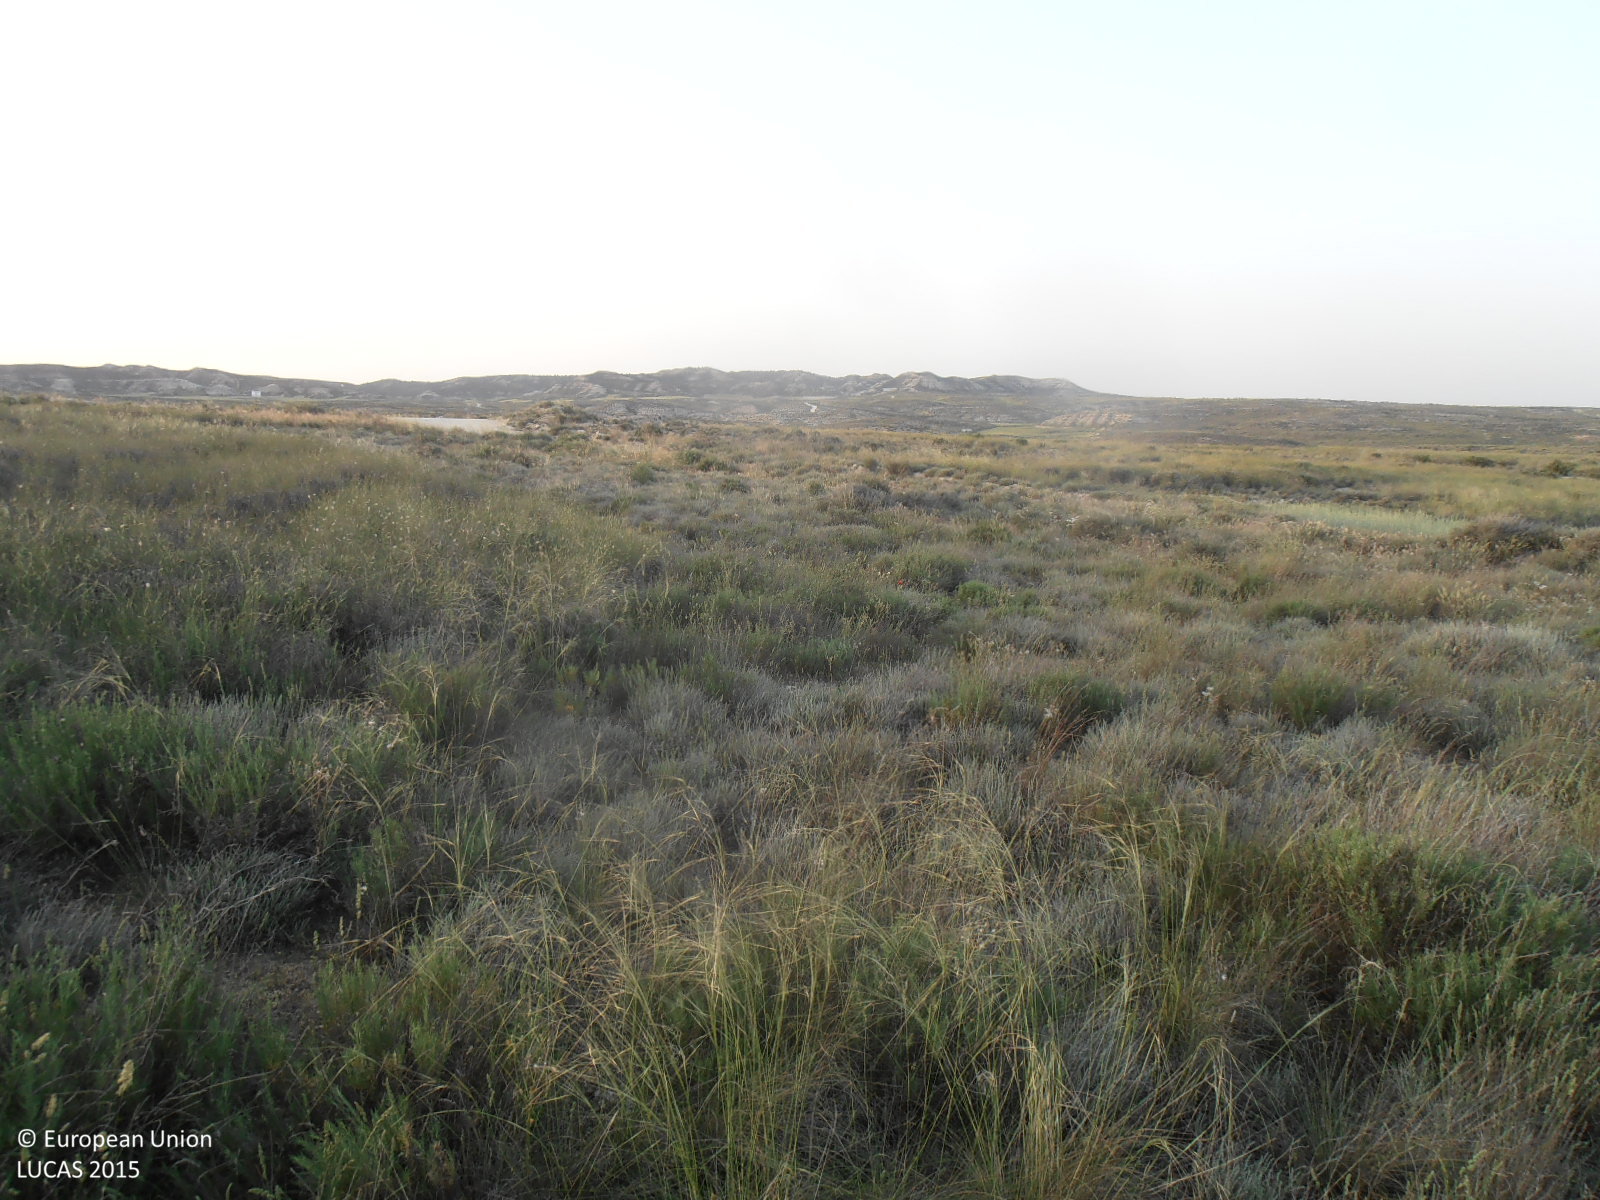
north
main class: Shrubland
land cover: Shrubland without tree cover
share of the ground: > 75 %
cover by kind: shrubs 90 %, herbaceous plants 10 %
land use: Semi-natural and natural areas not in use
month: May
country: ES
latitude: 41.5567
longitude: -1.0409
